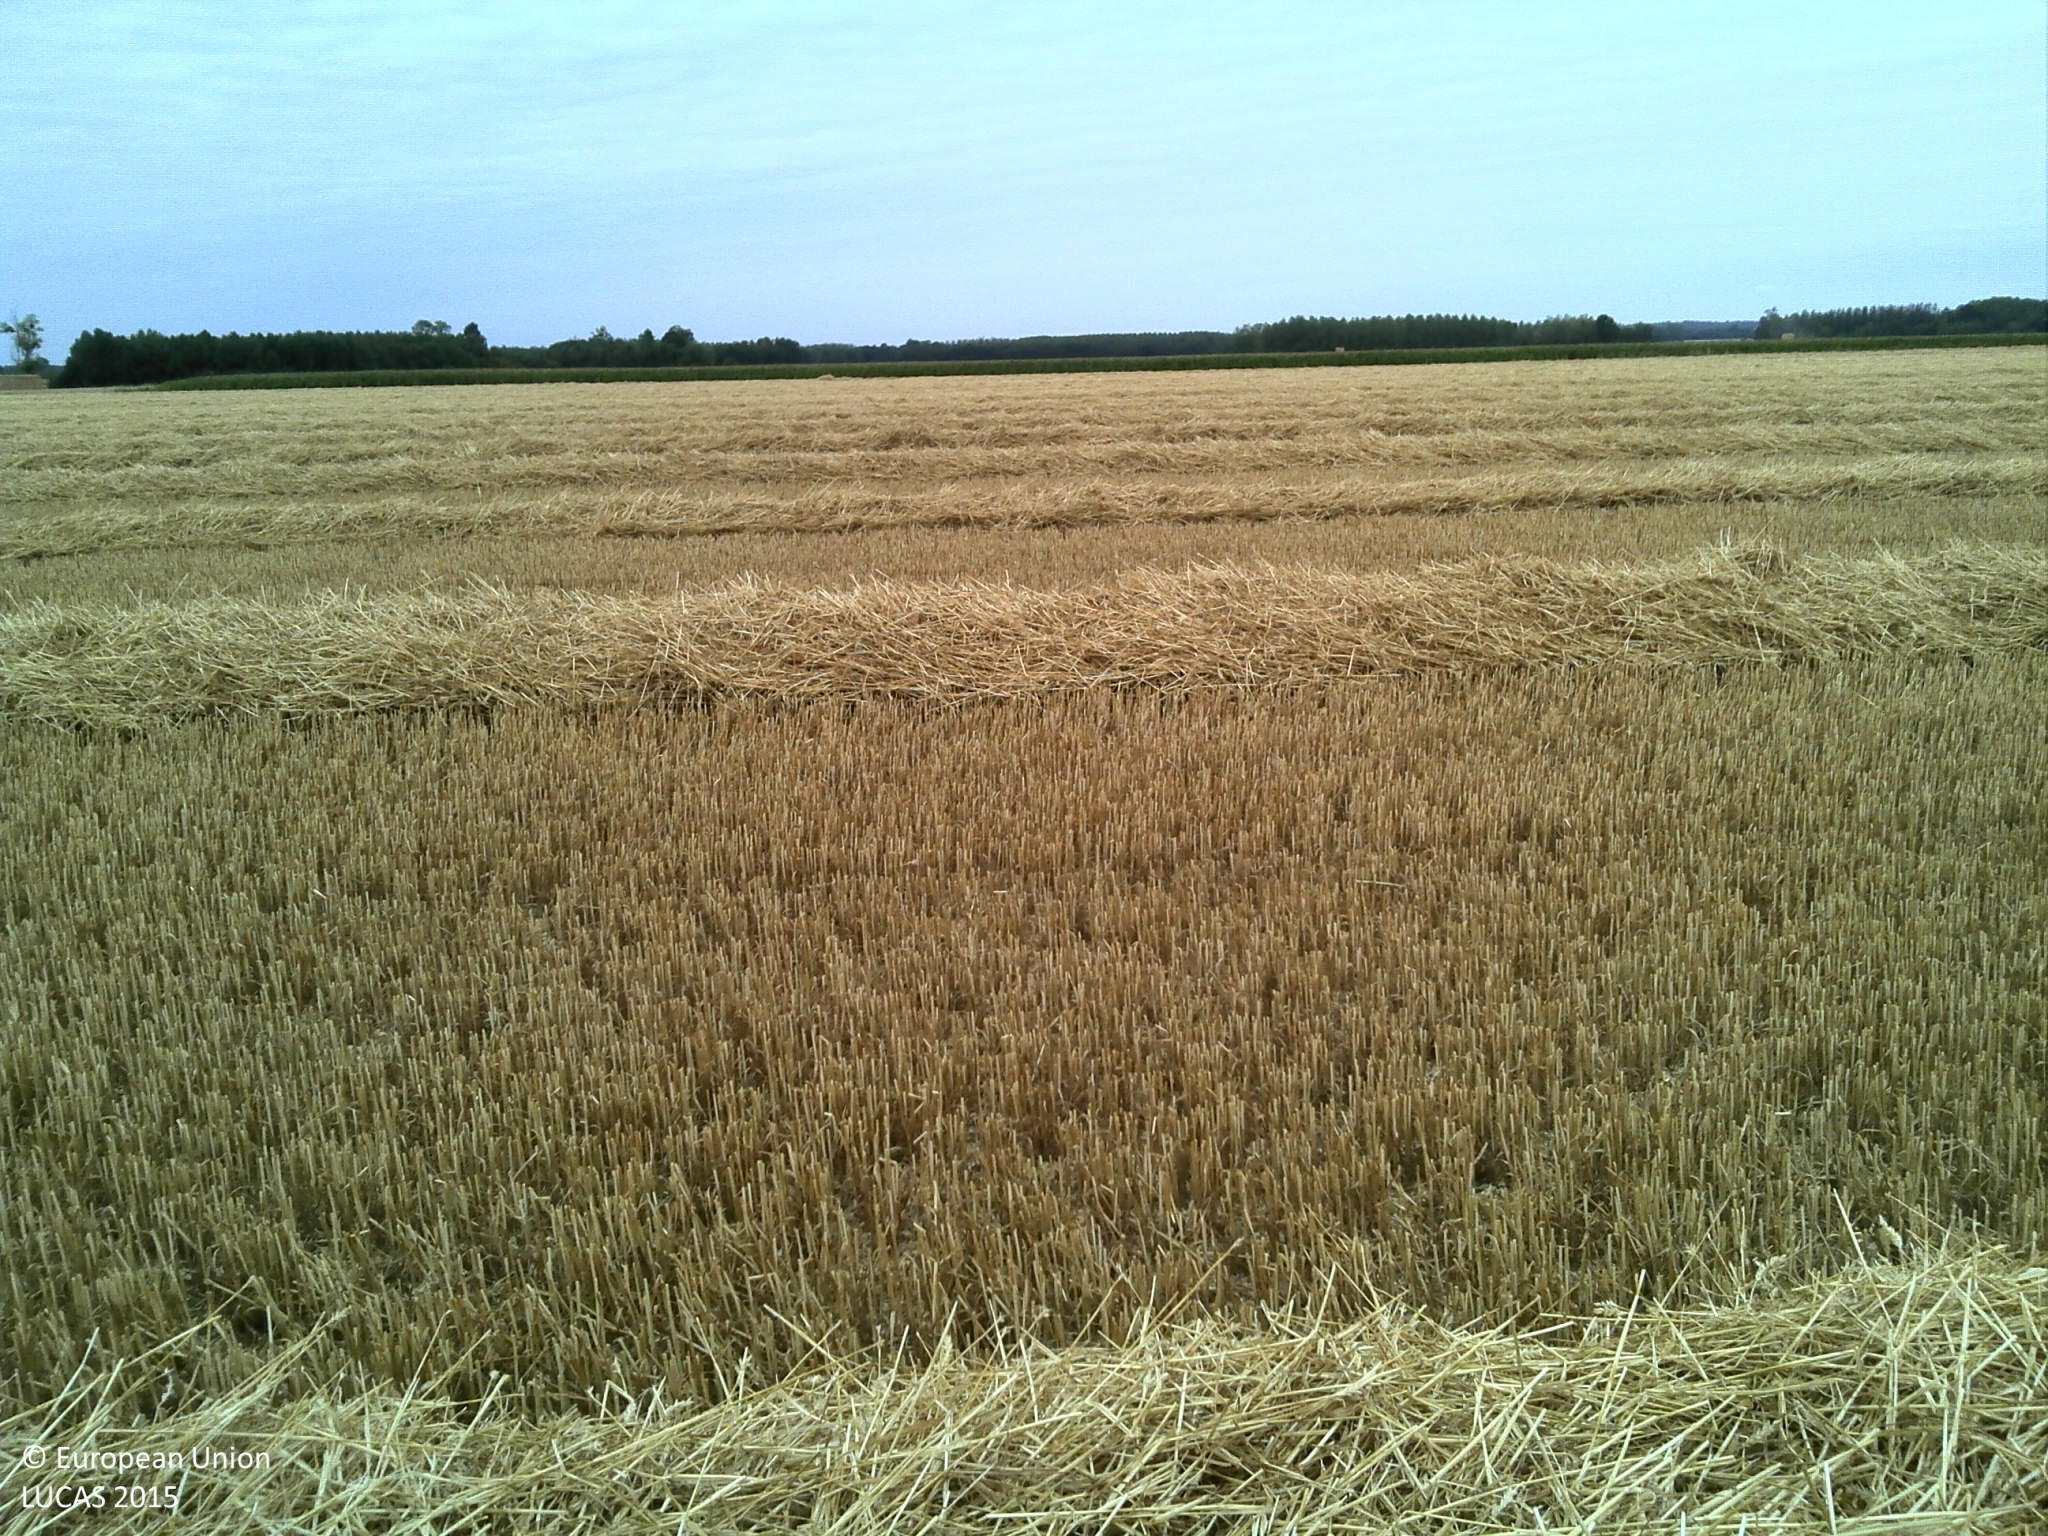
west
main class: Cropland
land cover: Common wheat
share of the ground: > 75 %
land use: Agriculture (excluding fallow land and kitchen gardens)
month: July
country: FR
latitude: 48.7481
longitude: 4.7615
